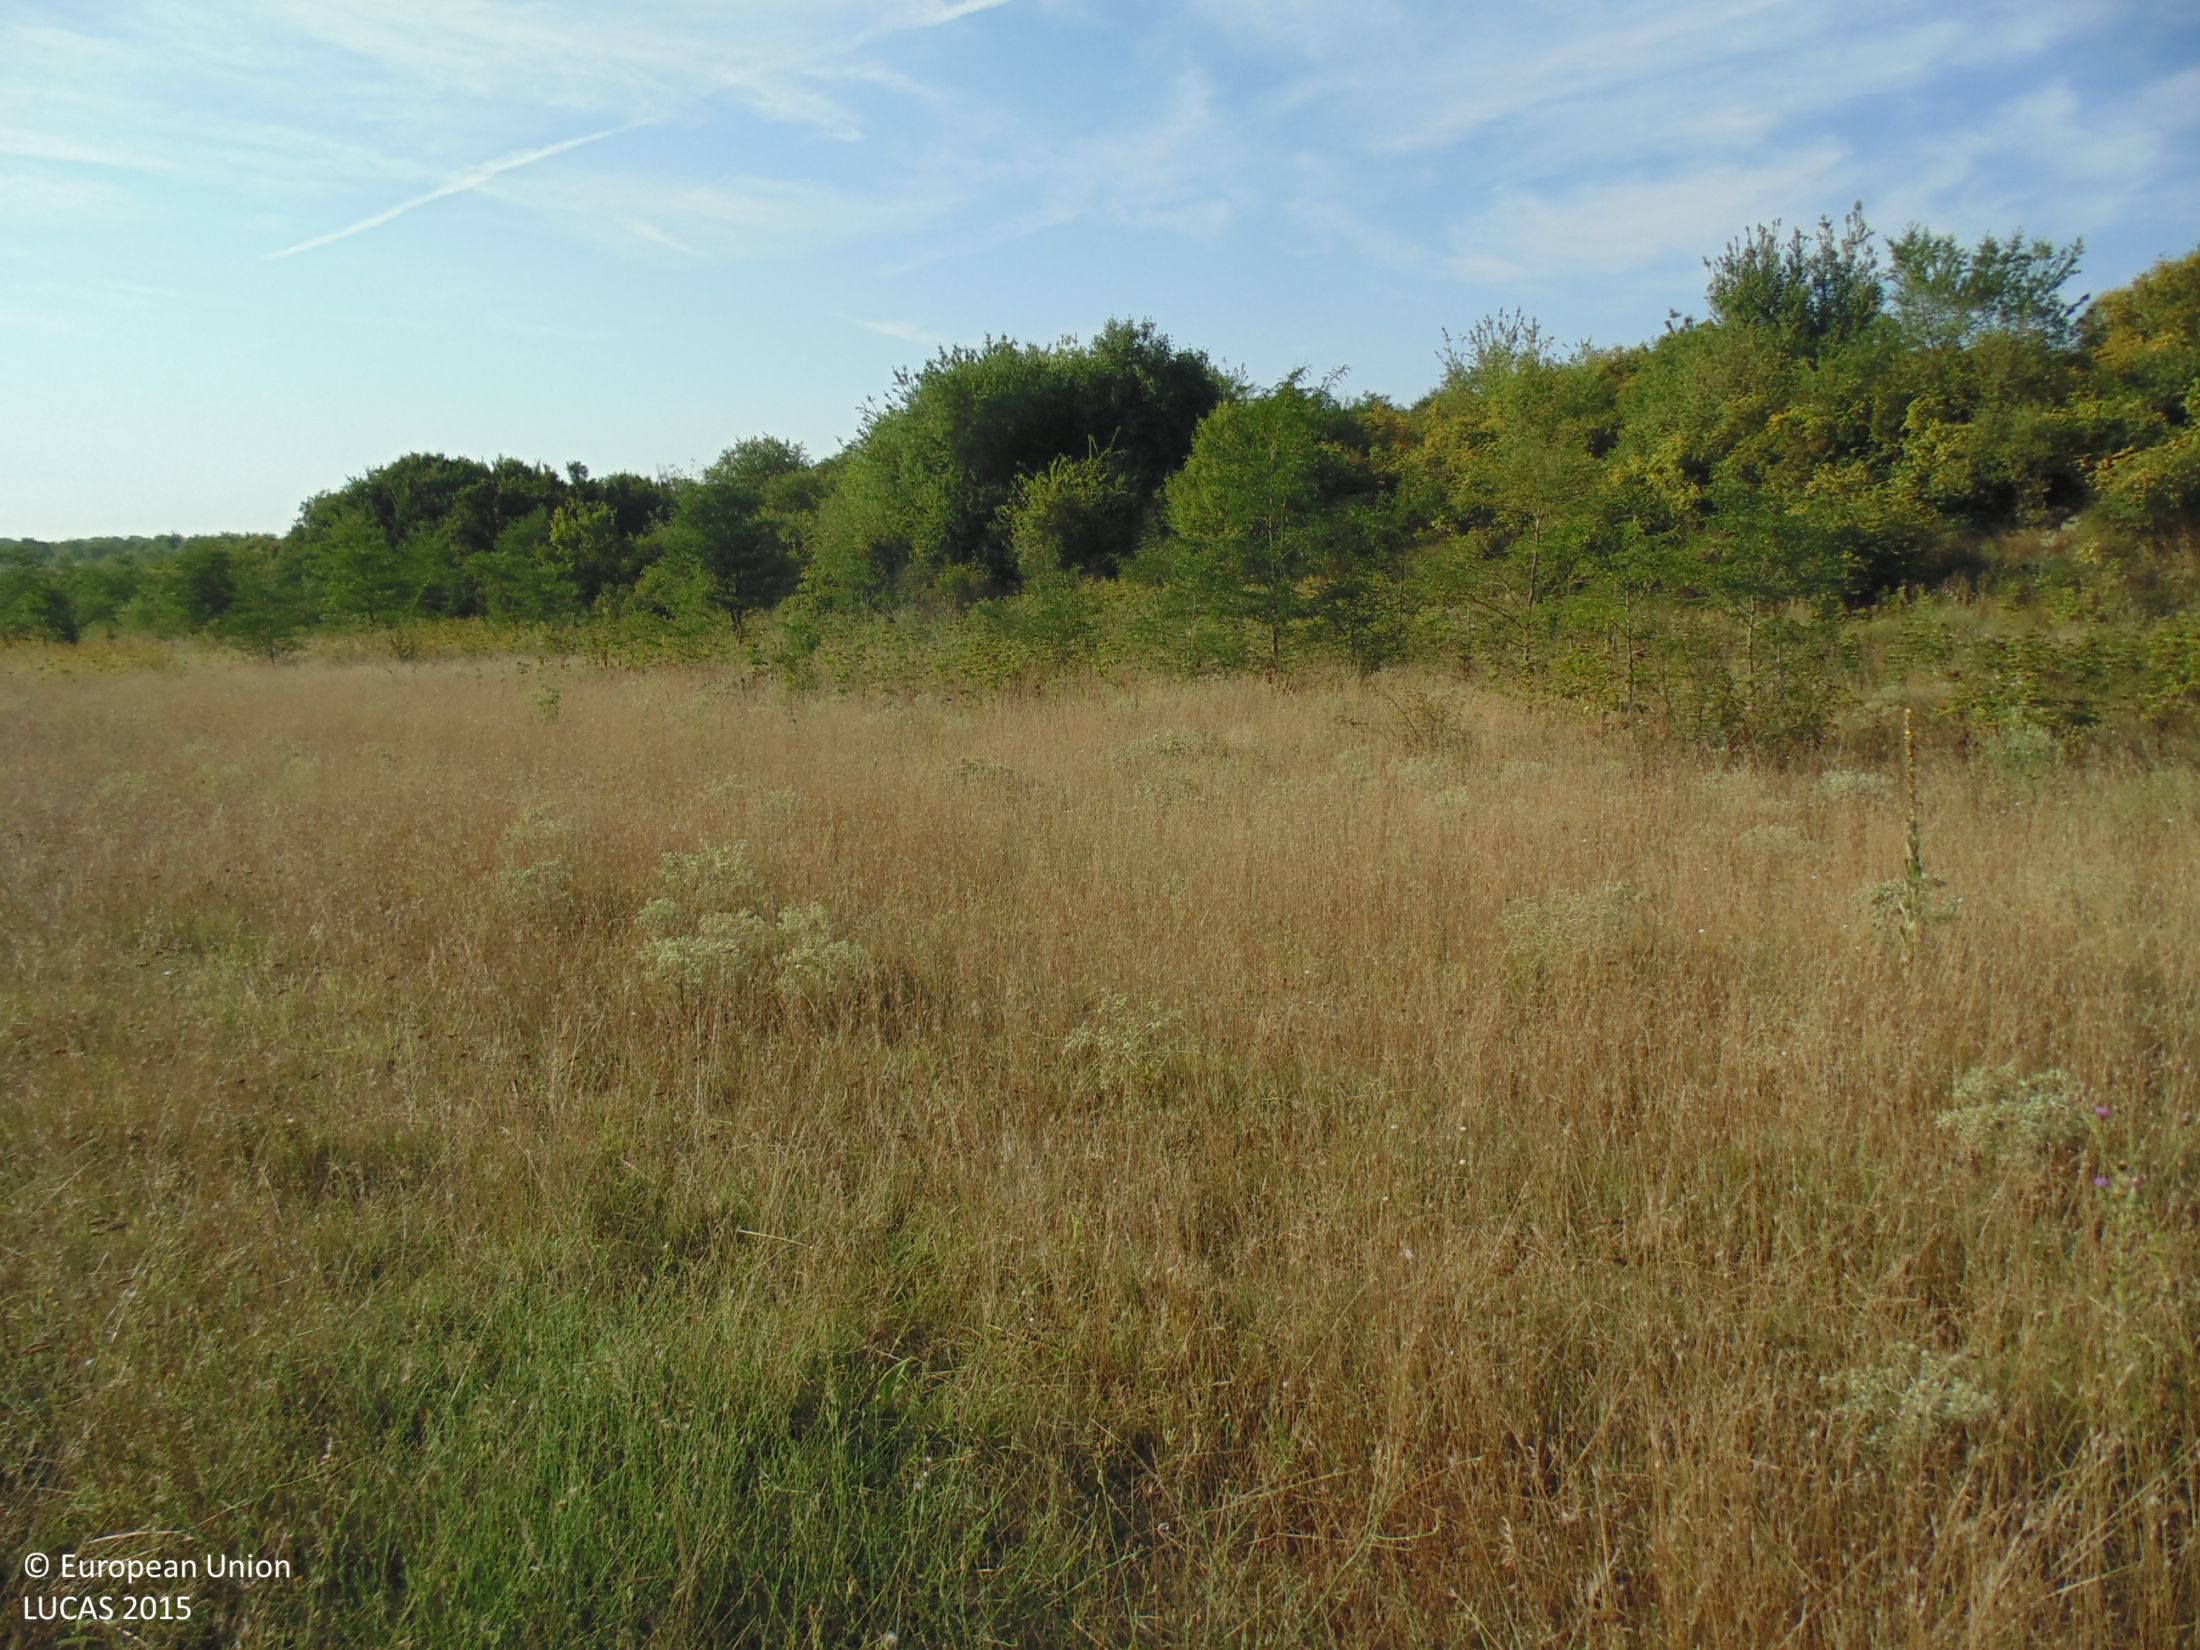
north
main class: Grassland
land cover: Grassland with sparse tree/shrub cover
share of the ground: > 75 %
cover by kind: herbaceous plants 90 %, broadleaved forest trees 5 %, shrubs 5 %
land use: Agriculture (excluding fallow land and kitchen gardens)
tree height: < 5 m
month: August
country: BG
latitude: 43.6658
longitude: 28.3003
